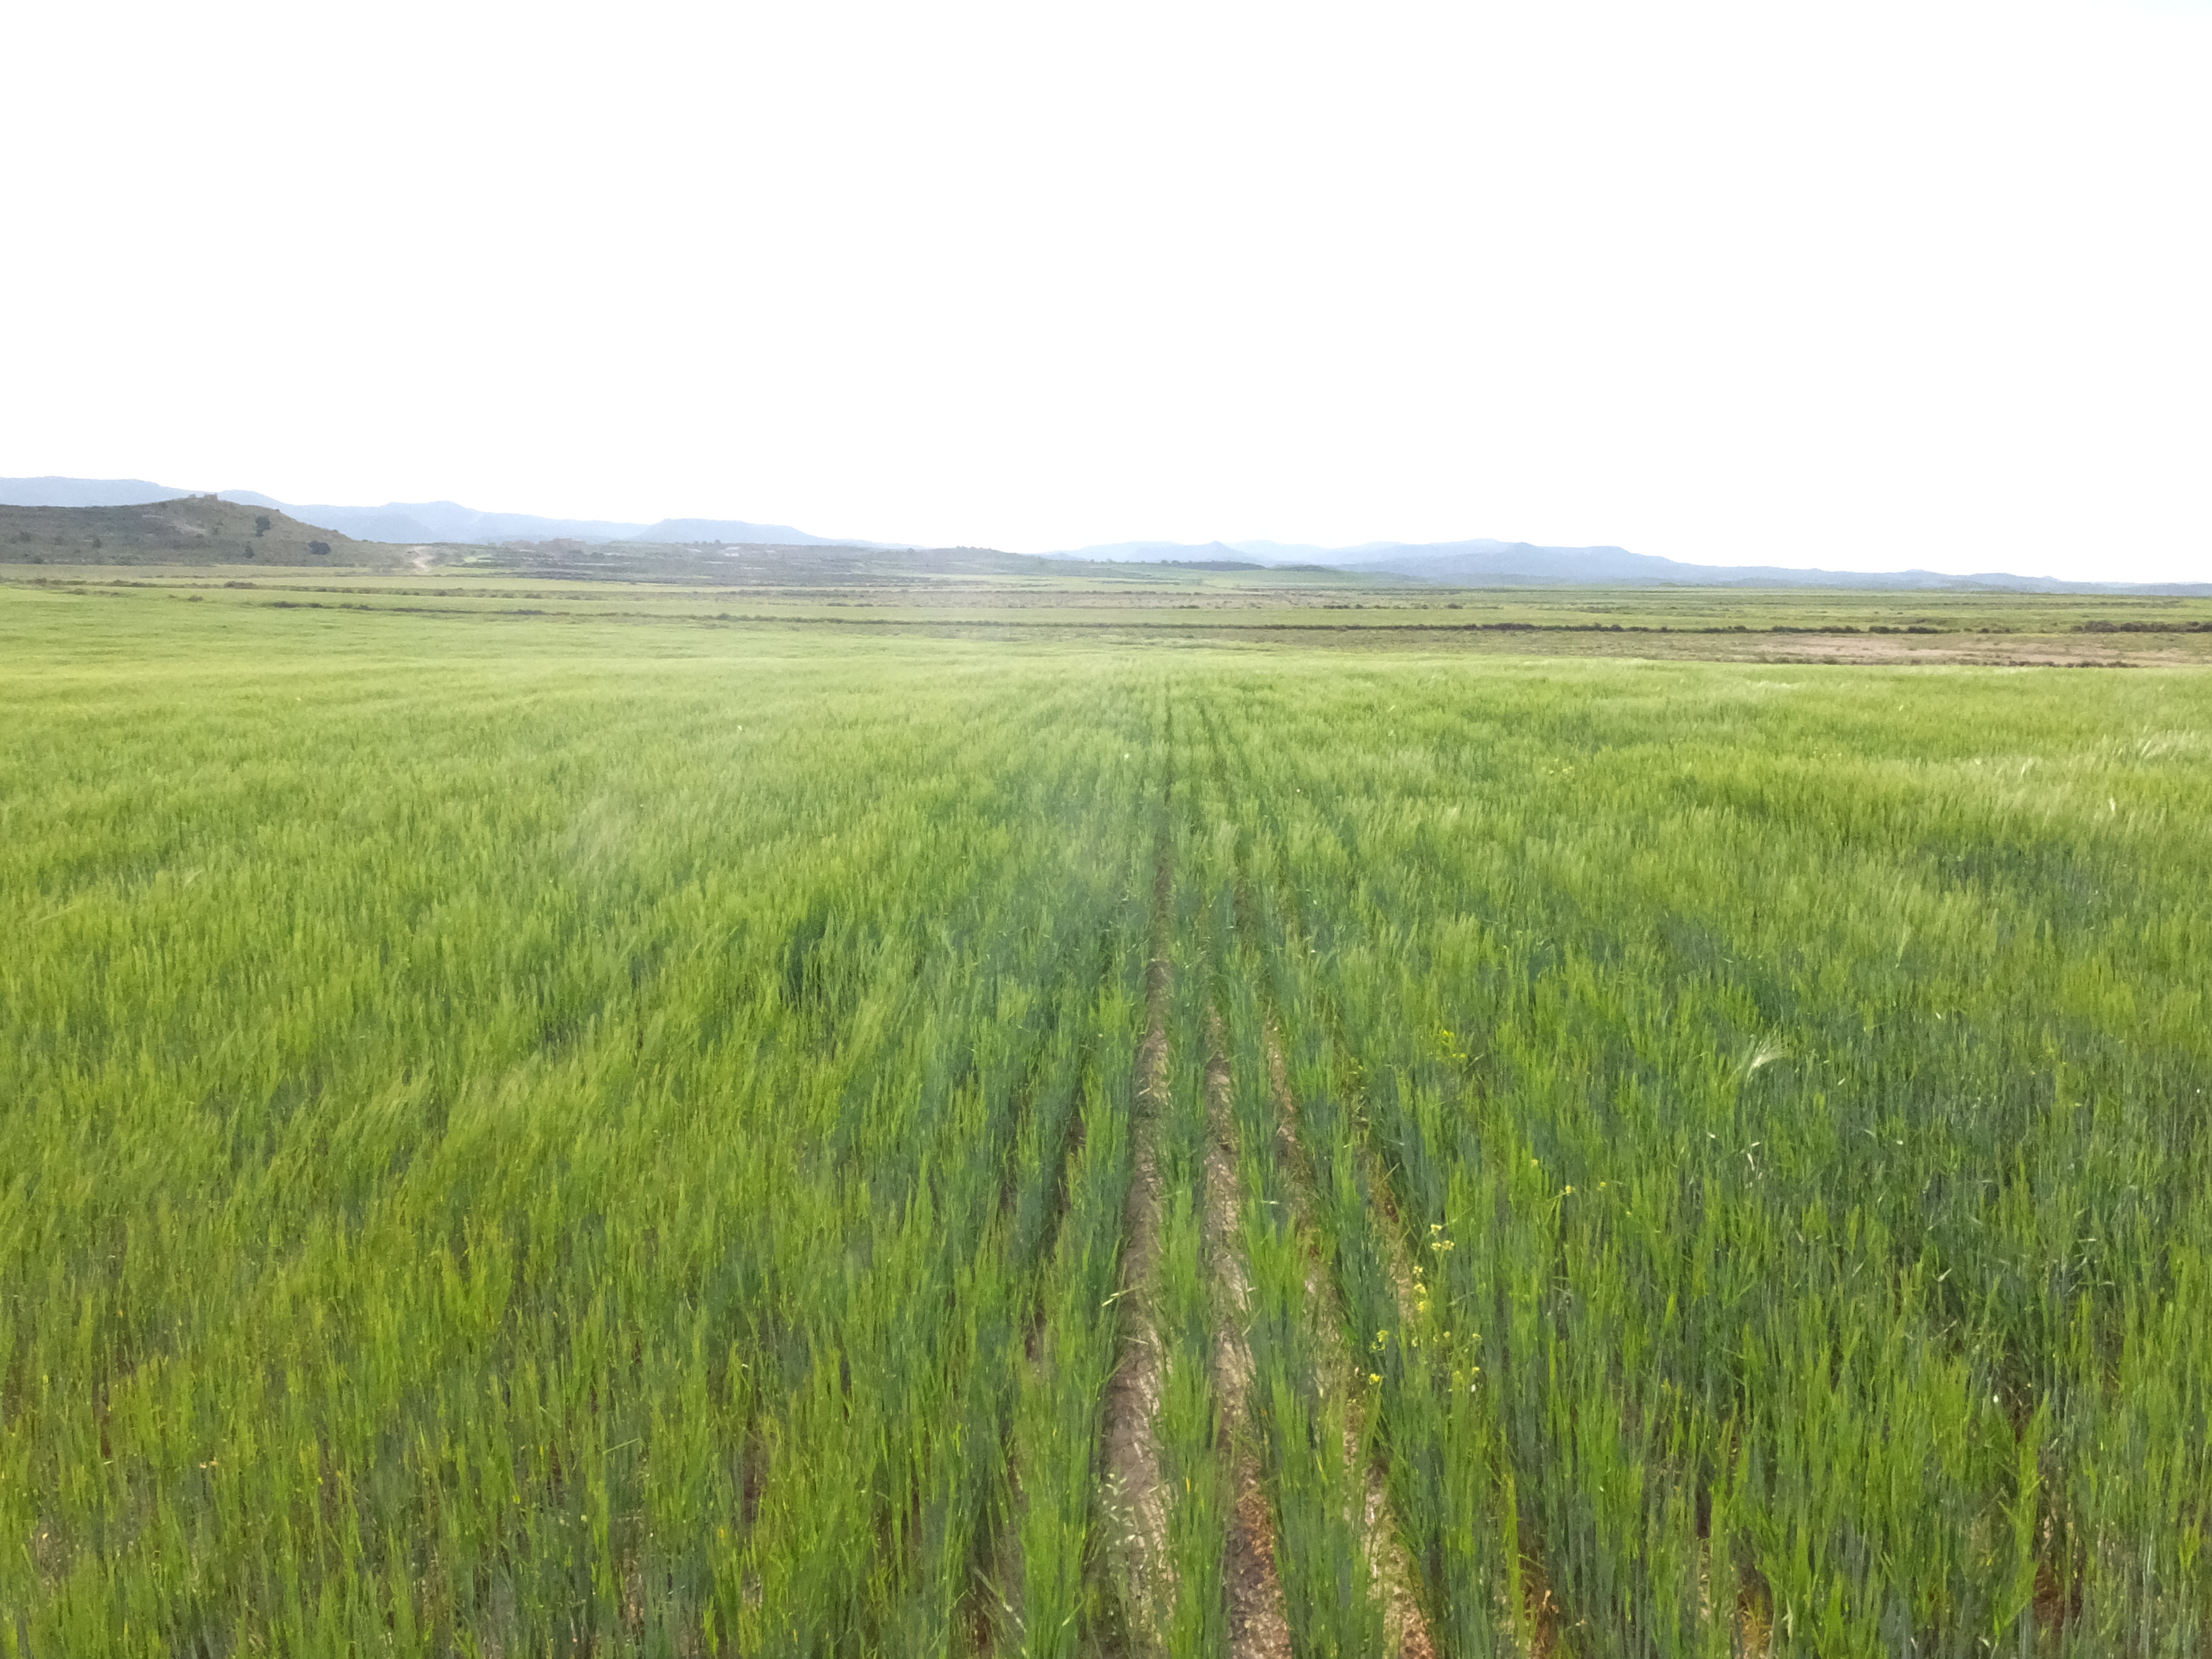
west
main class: Cropland
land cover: Barley
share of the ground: > 75 %
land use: Agriculture (excluding fallow land and kitchen gardens)
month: April
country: ES
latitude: 41.7227
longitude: -0.3444
